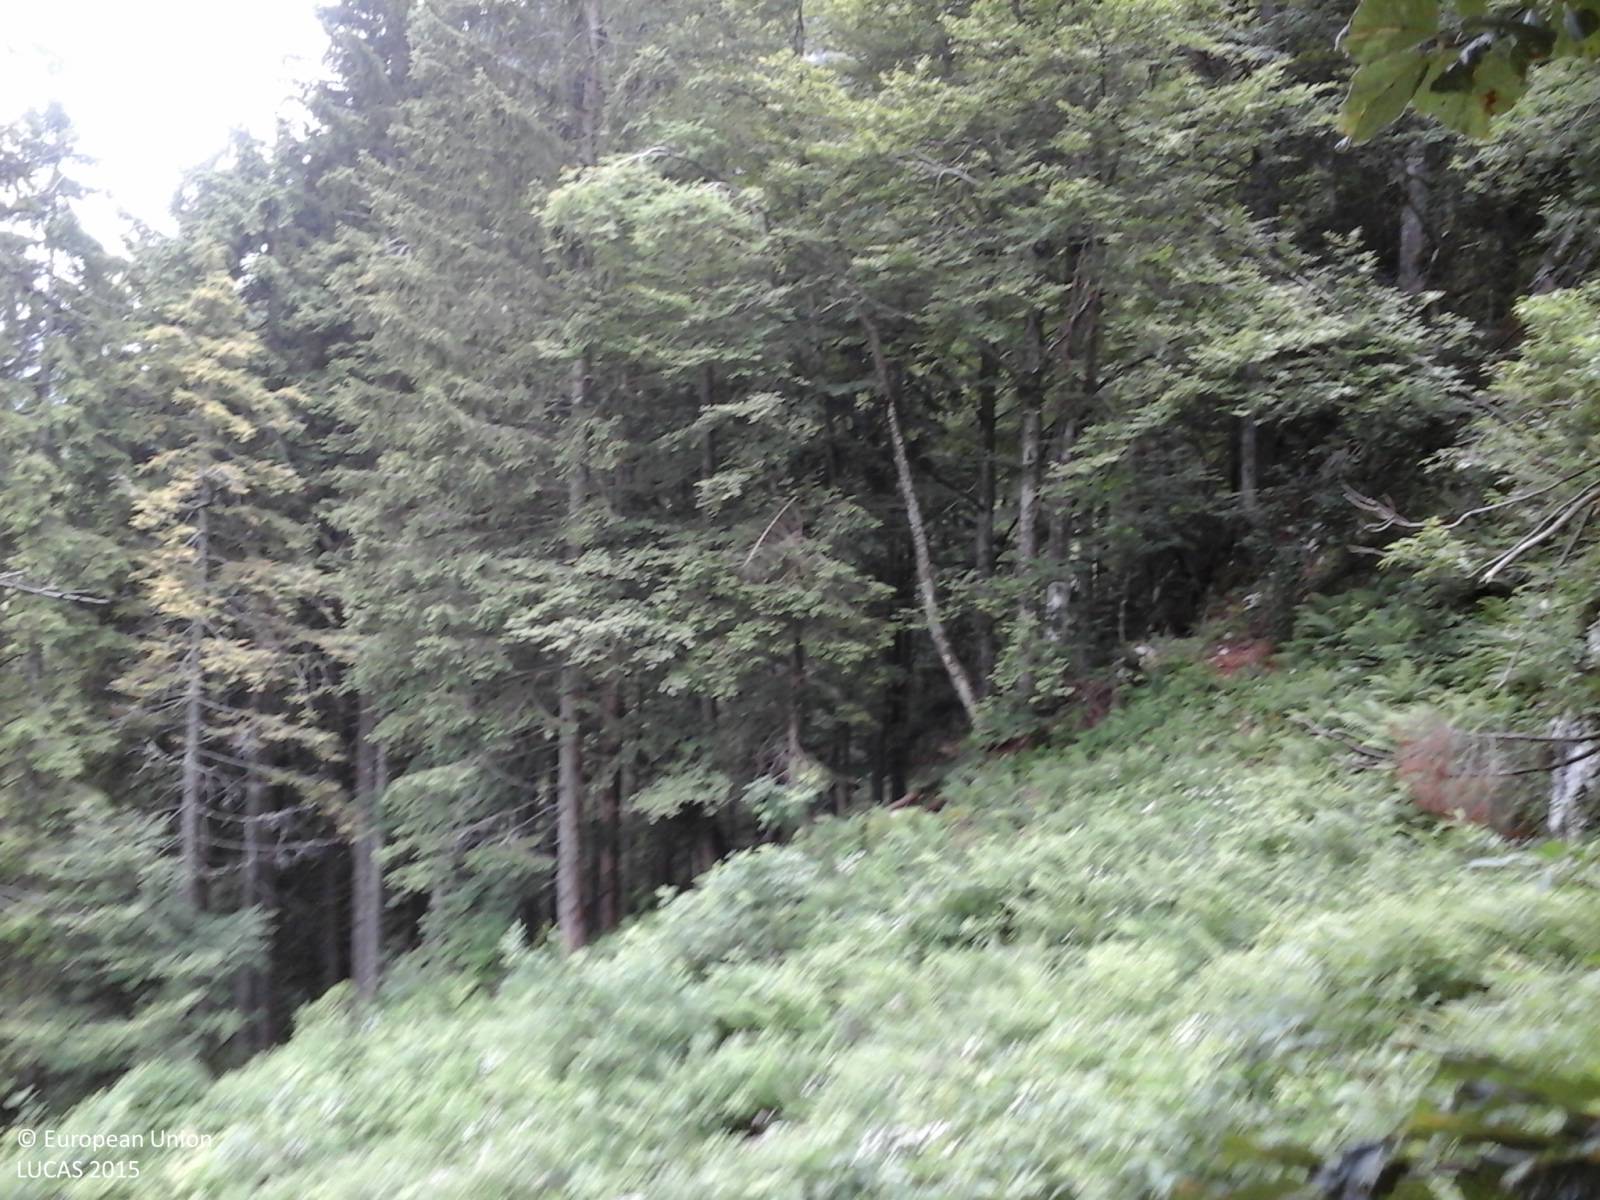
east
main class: Woodland
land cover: Other mixed woodland
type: alpine coniferous forest
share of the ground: > 75 %
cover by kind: coniferous forest trees 50 %, broadleaved forest trees 50 %
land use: Semi-natural and natural areas not in use
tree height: > 5 m
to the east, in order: Other mixed woodland; Electric lines; Other mixed woodland
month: June
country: IT
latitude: 46.3851
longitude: 13.4686
